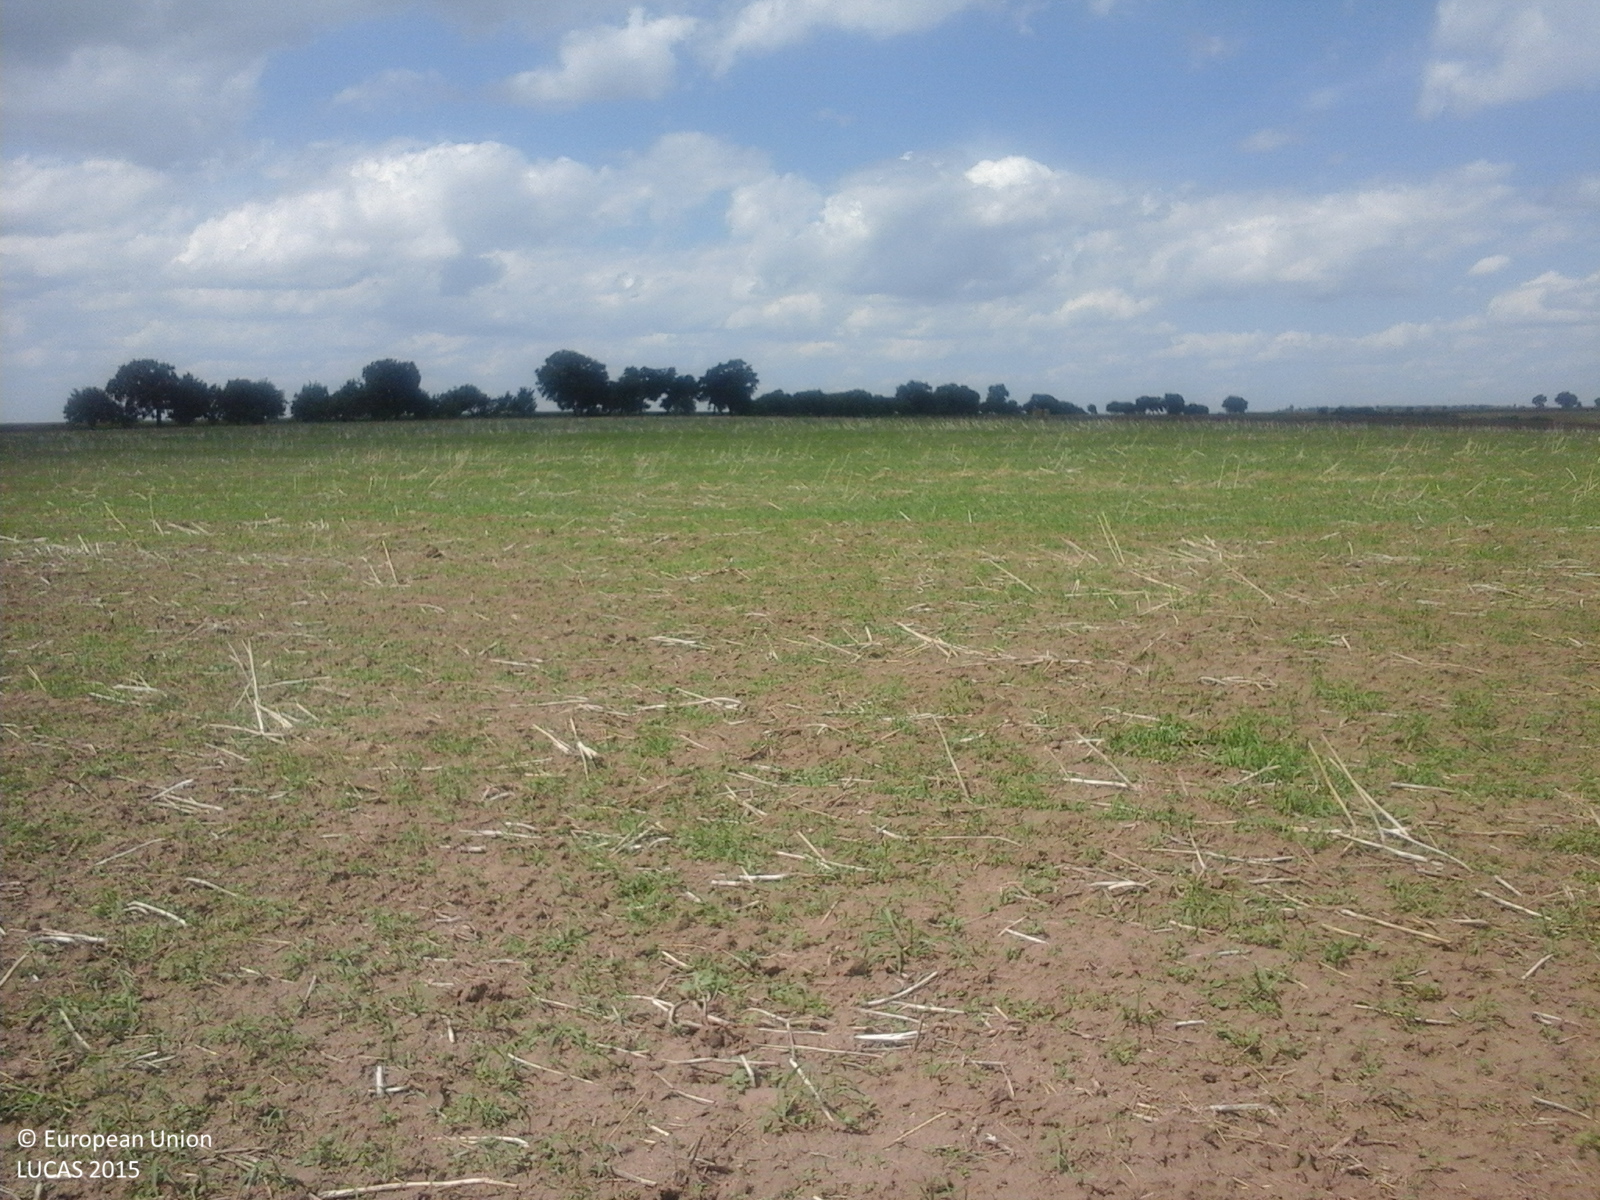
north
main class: Cropland
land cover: Rape and turnip rape
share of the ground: < 10 %
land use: Agriculture (excluding fallow land and kitchen gardens)
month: July
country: RO
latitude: 46.4355
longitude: 27.8607
